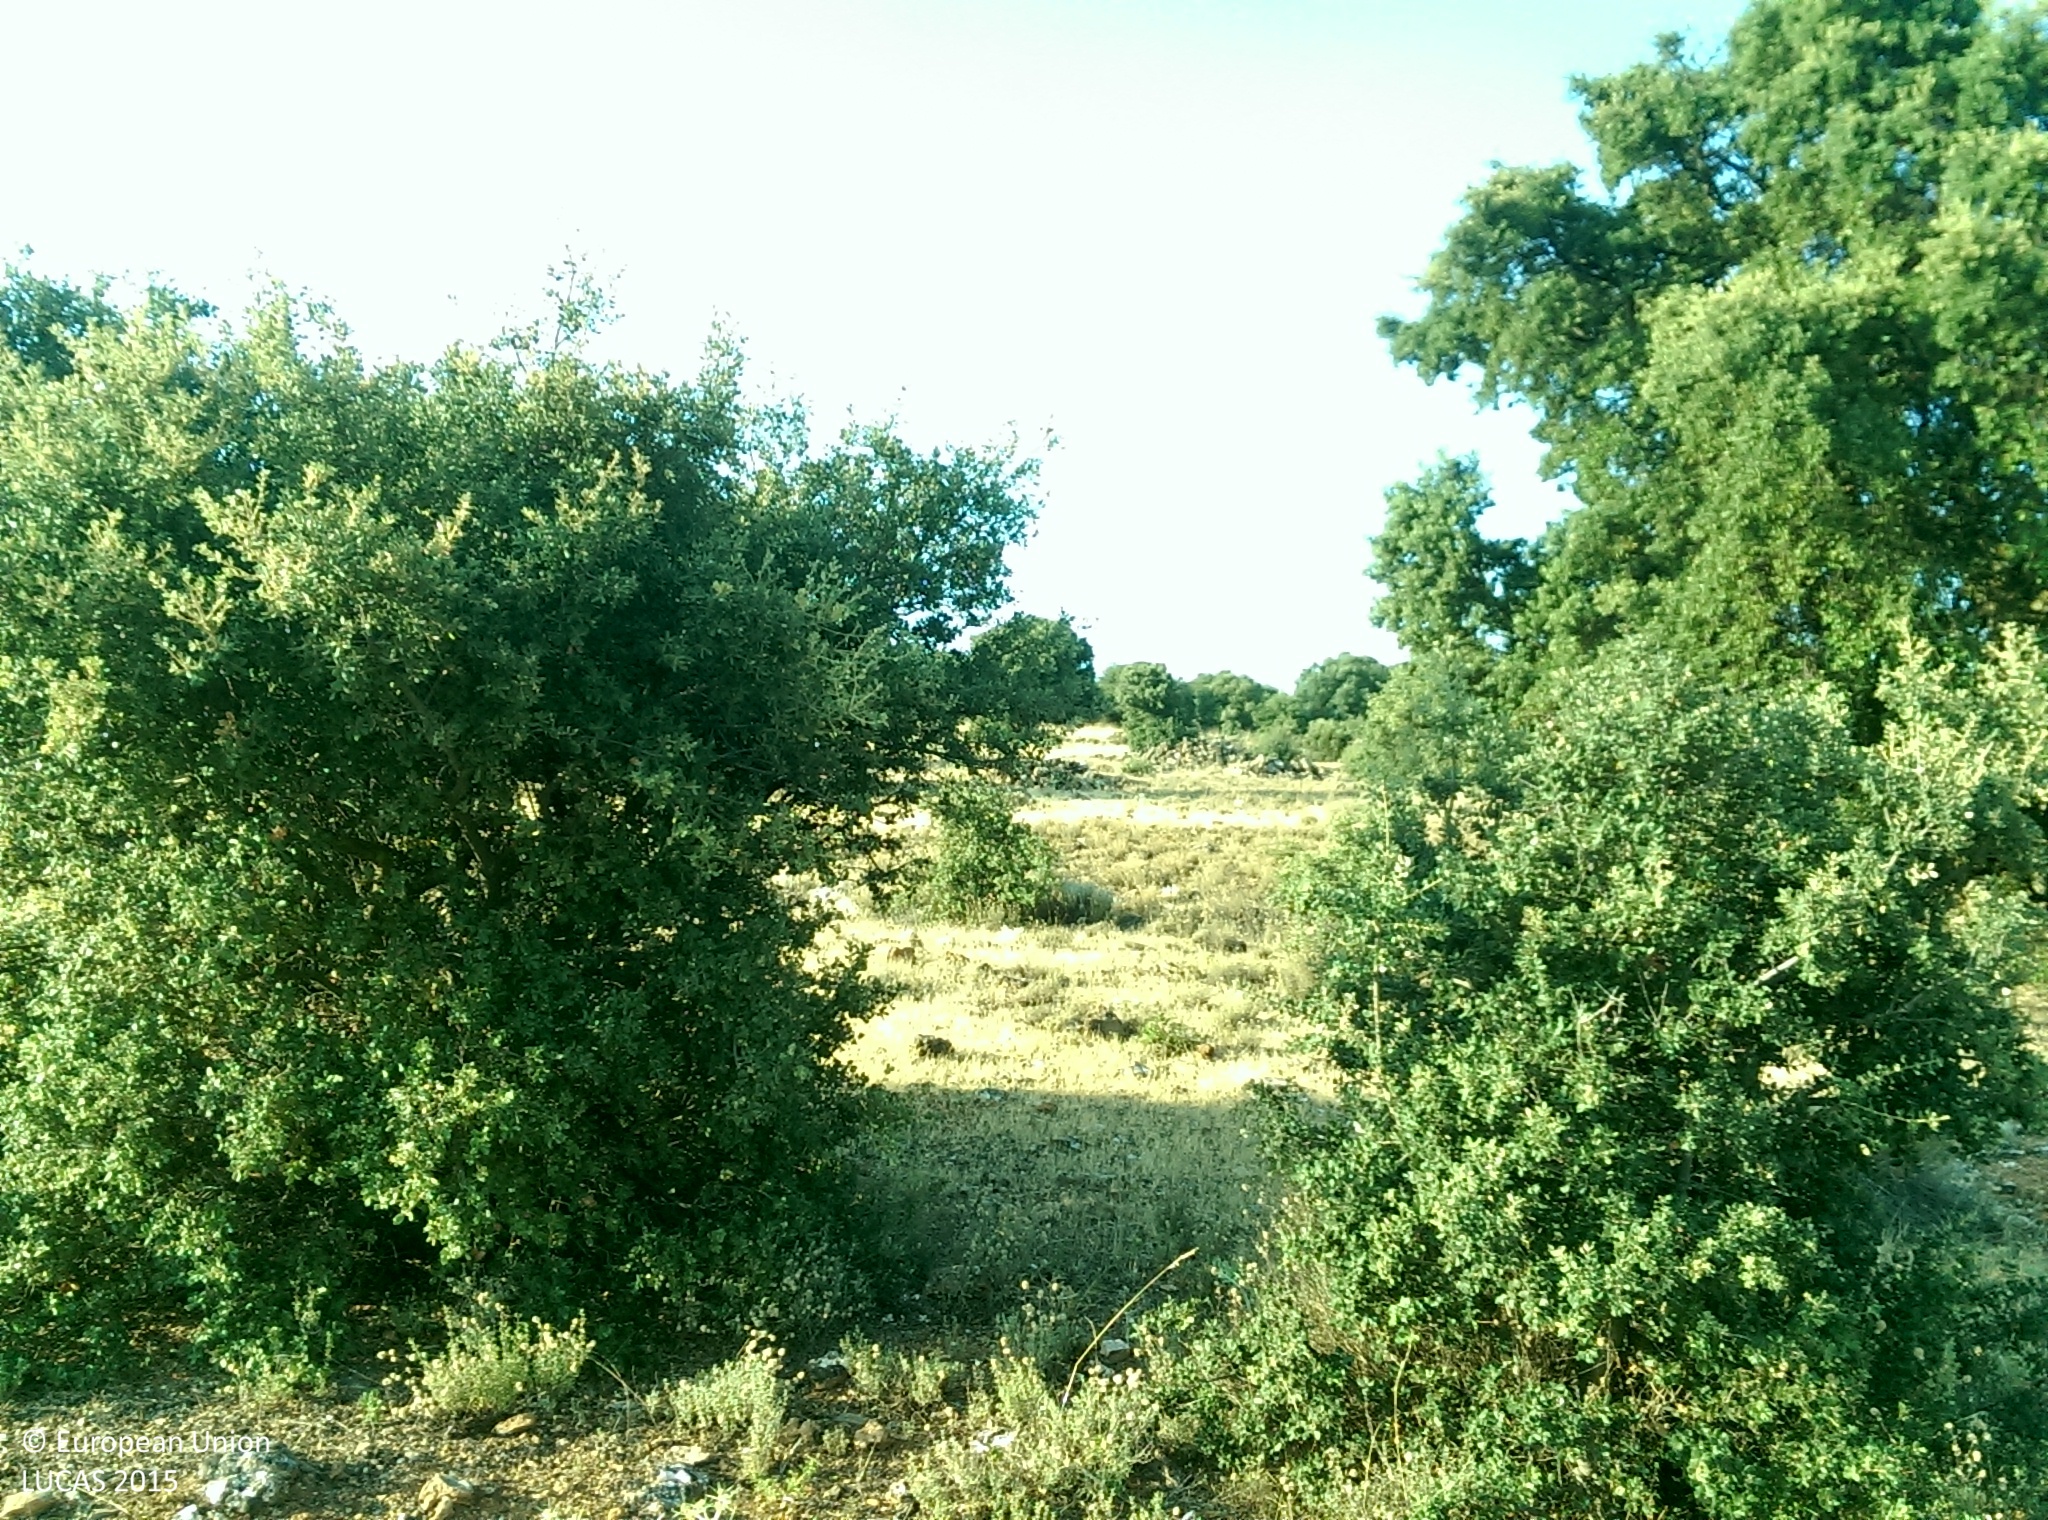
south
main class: Grassland
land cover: Grassland with sparse tree/shrub cover
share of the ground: > 75 %
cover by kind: herbaceous plants 90 %, broadleaved forest trees 5 %, shrubs 5 %
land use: Semi-natural and natural areas not in use
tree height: > 5 m
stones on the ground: > 50 %
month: July
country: ES
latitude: 37.3910
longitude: -2.9424
